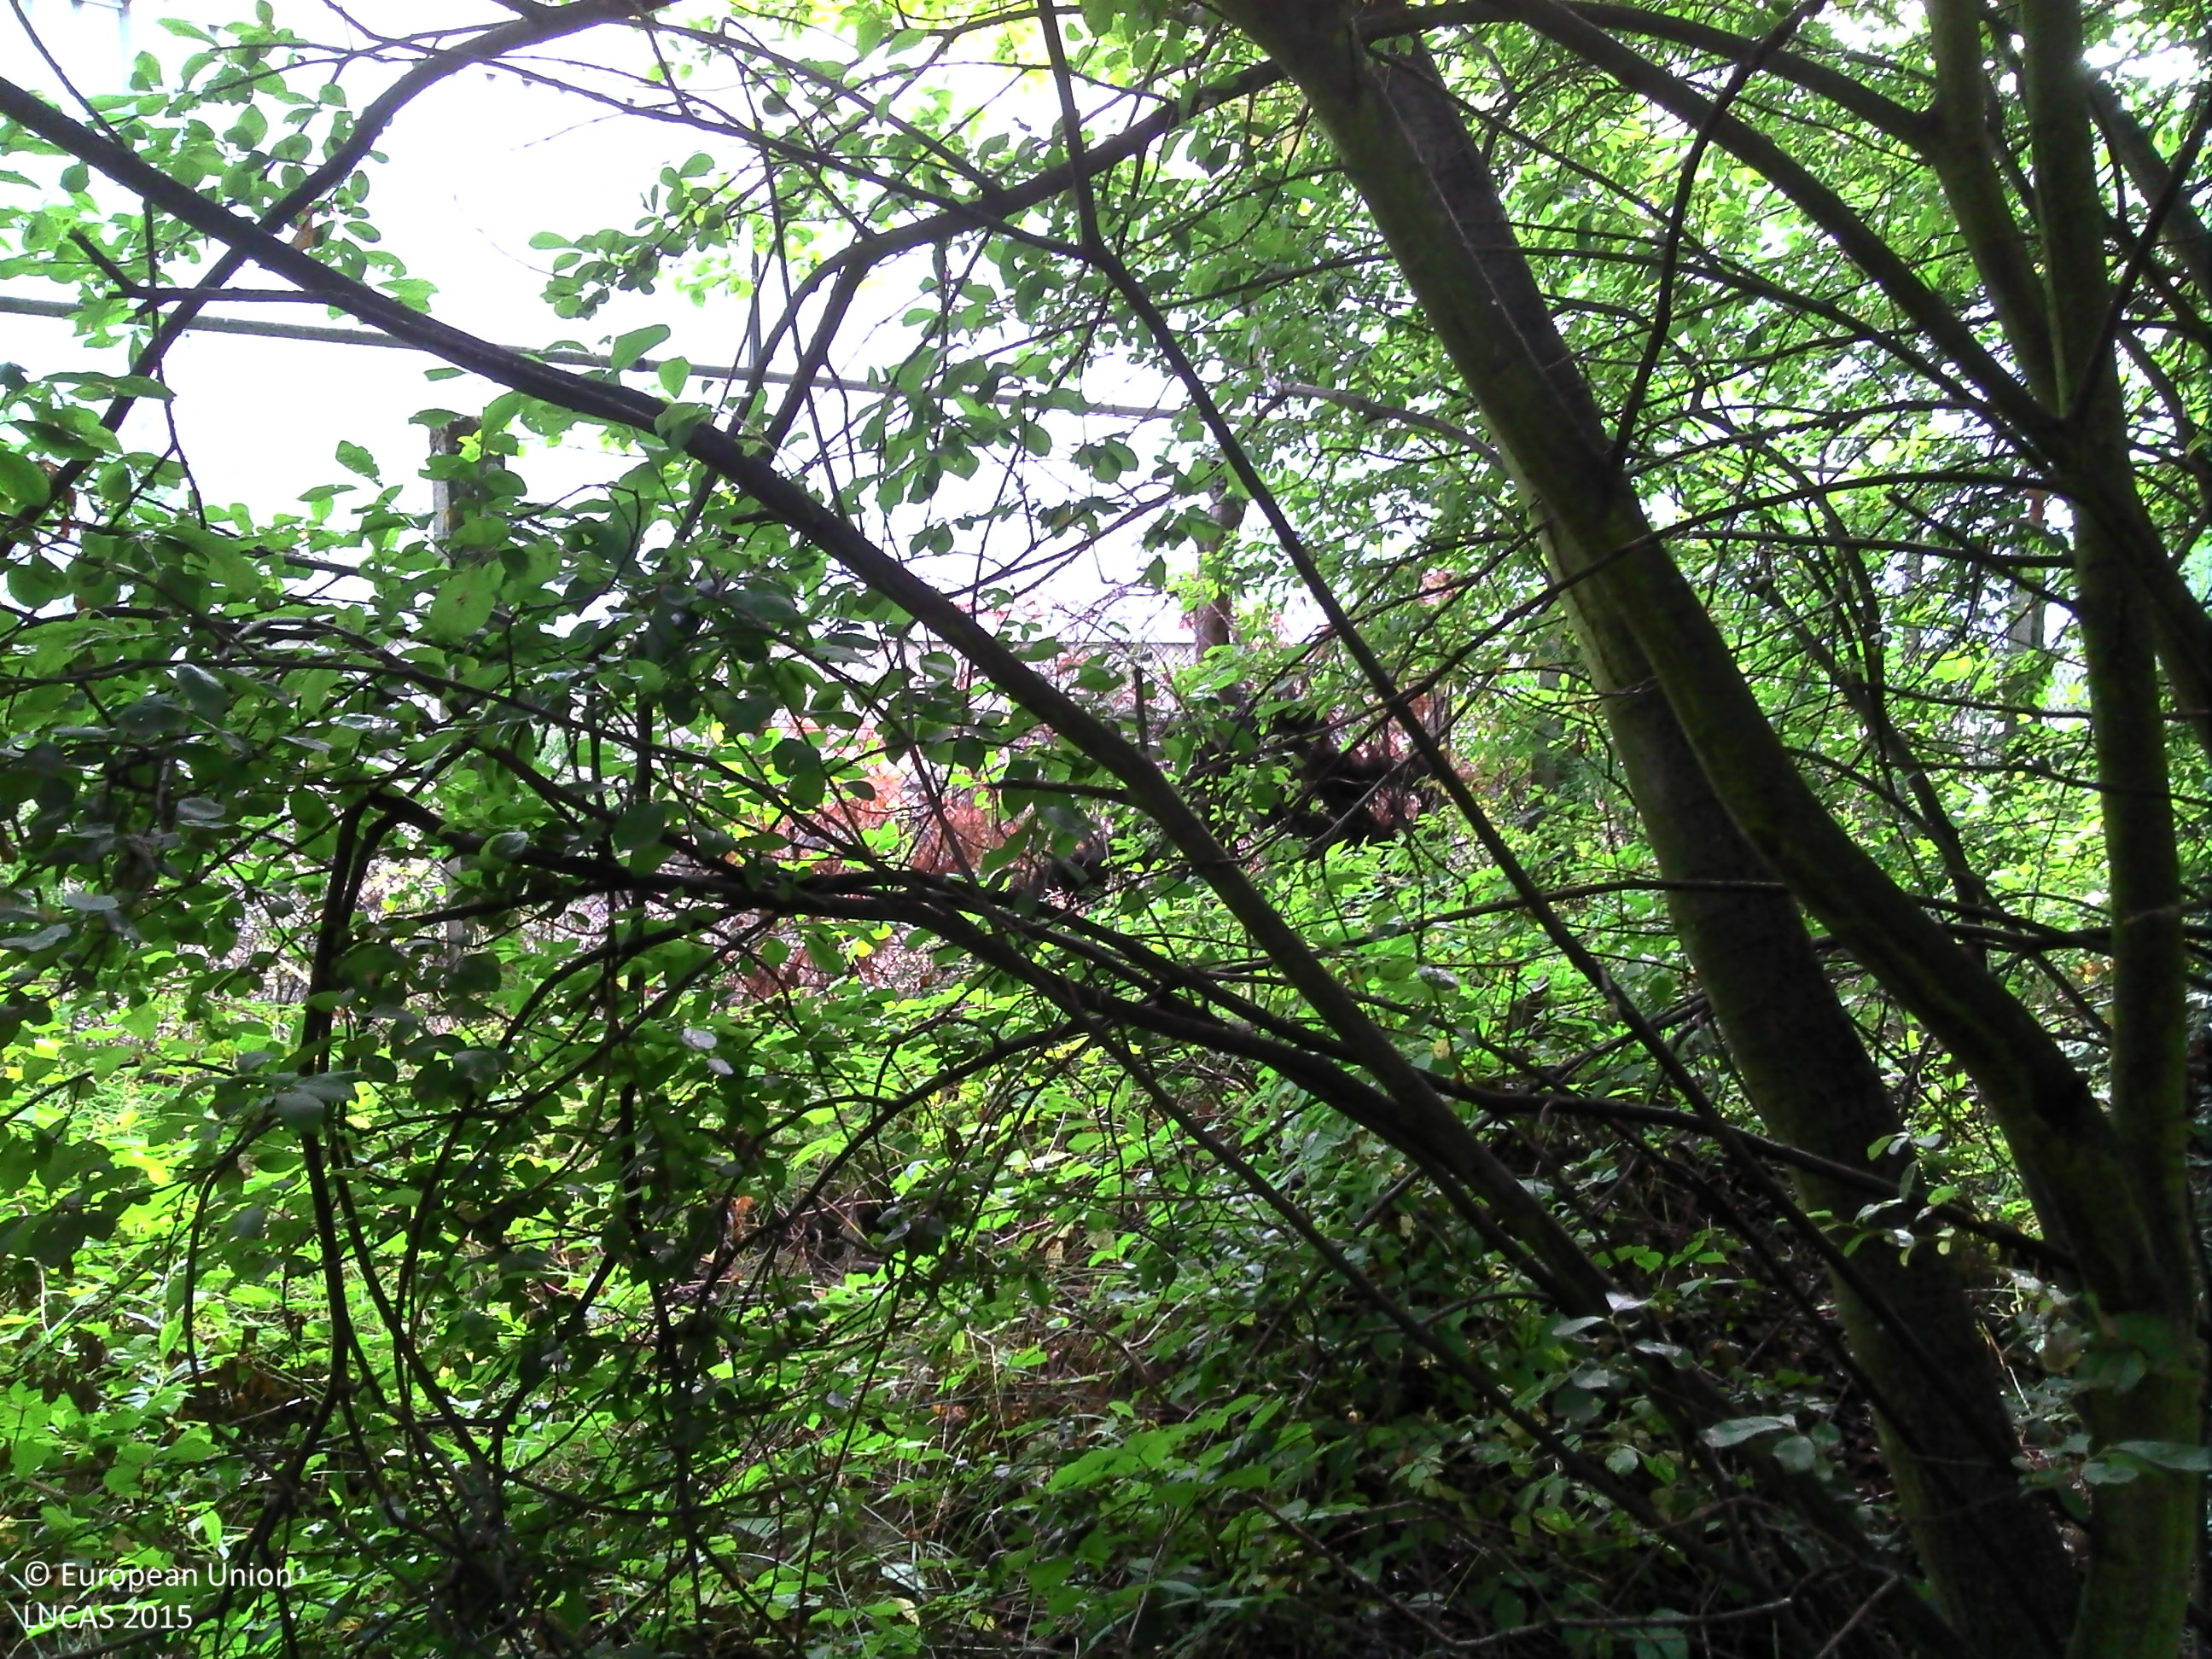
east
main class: Woodland
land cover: Broadleaved woodland
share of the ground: > 75 %
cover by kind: broadleaved forest trees 80 %, herbaceous plants 20 %
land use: Semi-natural and natural areas not in use
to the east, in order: Broadleaved woodland; Artificial constructions in urban areas
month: June
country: BE
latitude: 51.0722
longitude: 5.1593
